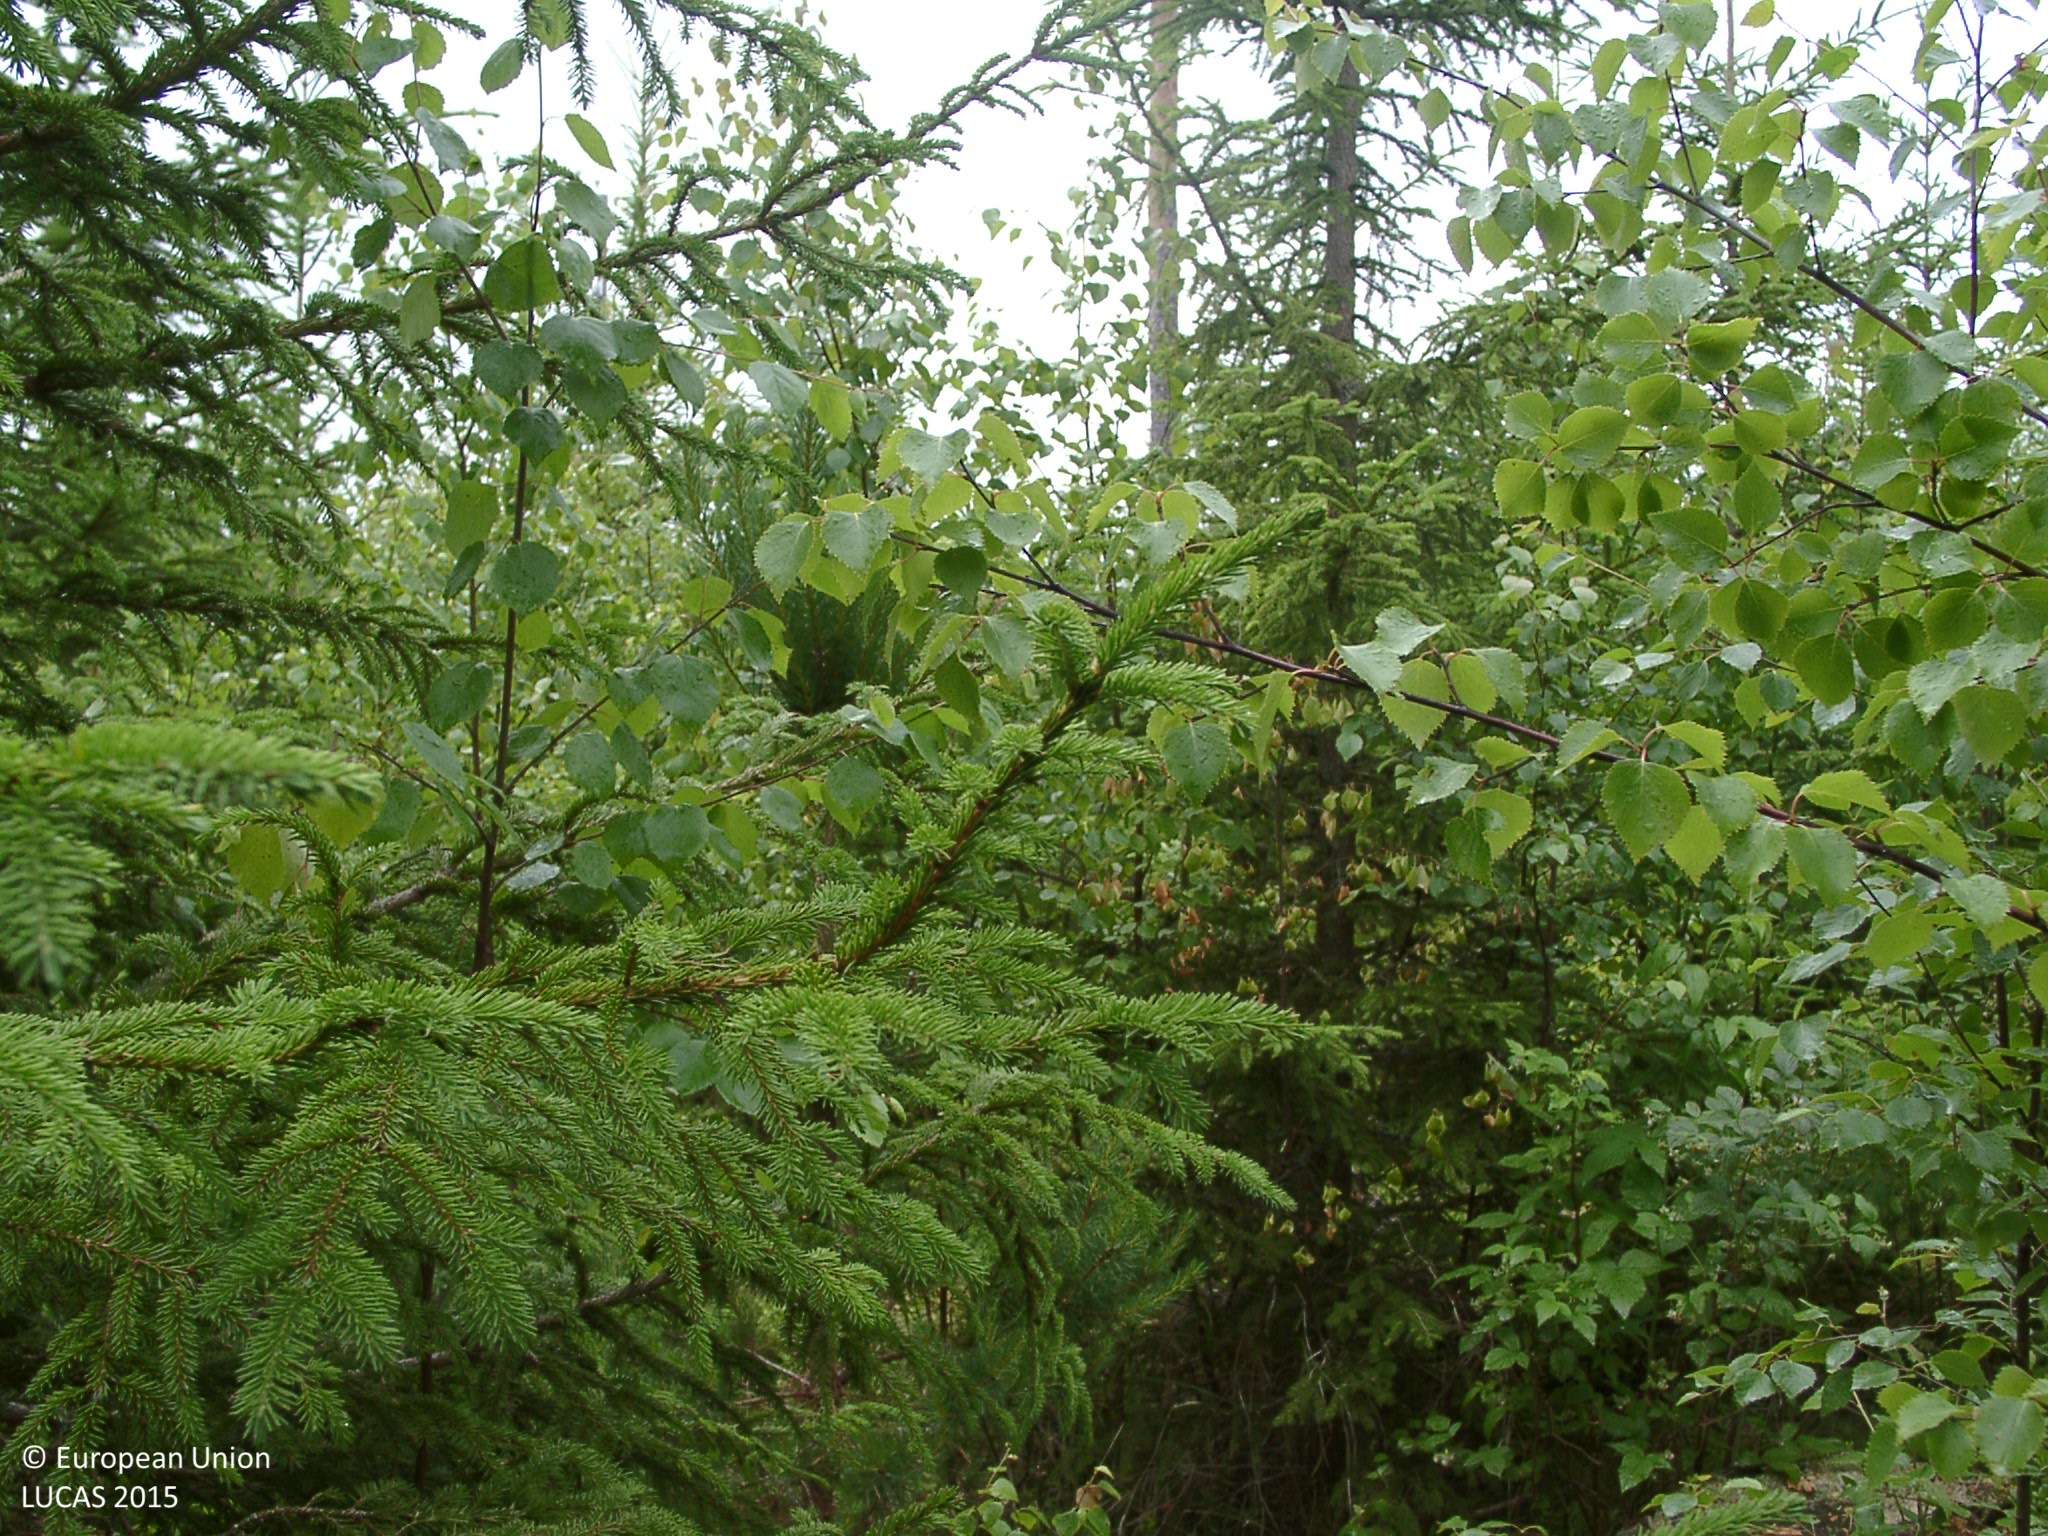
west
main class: Woodland
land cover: Spruce dominated mixed woodland
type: boreal forest
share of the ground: > 75 %
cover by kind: broadleaved forest trees 45 %, coniferous forest trees 40 %, shrubs 10 %, herbaceous plants 5 %
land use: Forestry
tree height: < 5 m
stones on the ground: < 10 %
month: July
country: FI
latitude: 61.5450
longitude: 25.1446
